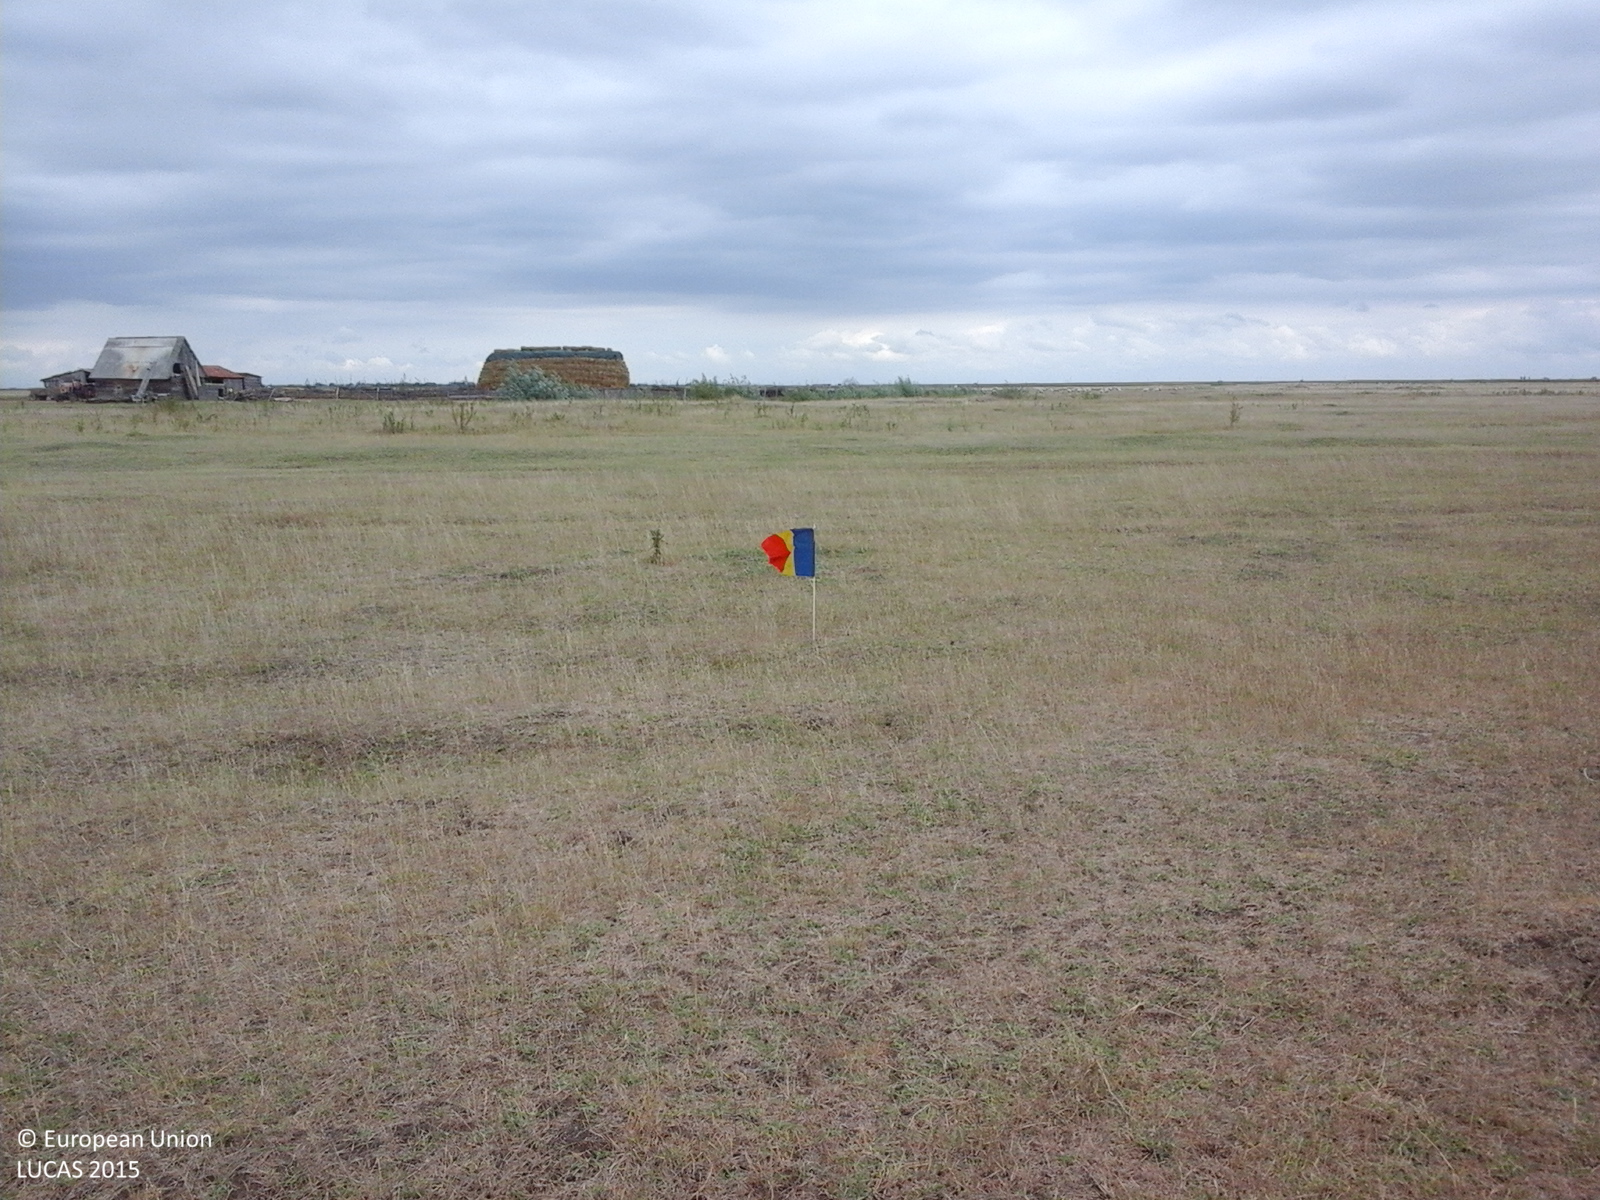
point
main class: Grassland
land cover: Grassland without tree/shrub cover
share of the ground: > 75 %
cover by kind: herbaceous plants 100 %
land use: Agriculture (excluding fallow land and kitchen gardens)
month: August
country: RO
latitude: 45.5125
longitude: 20.9708
